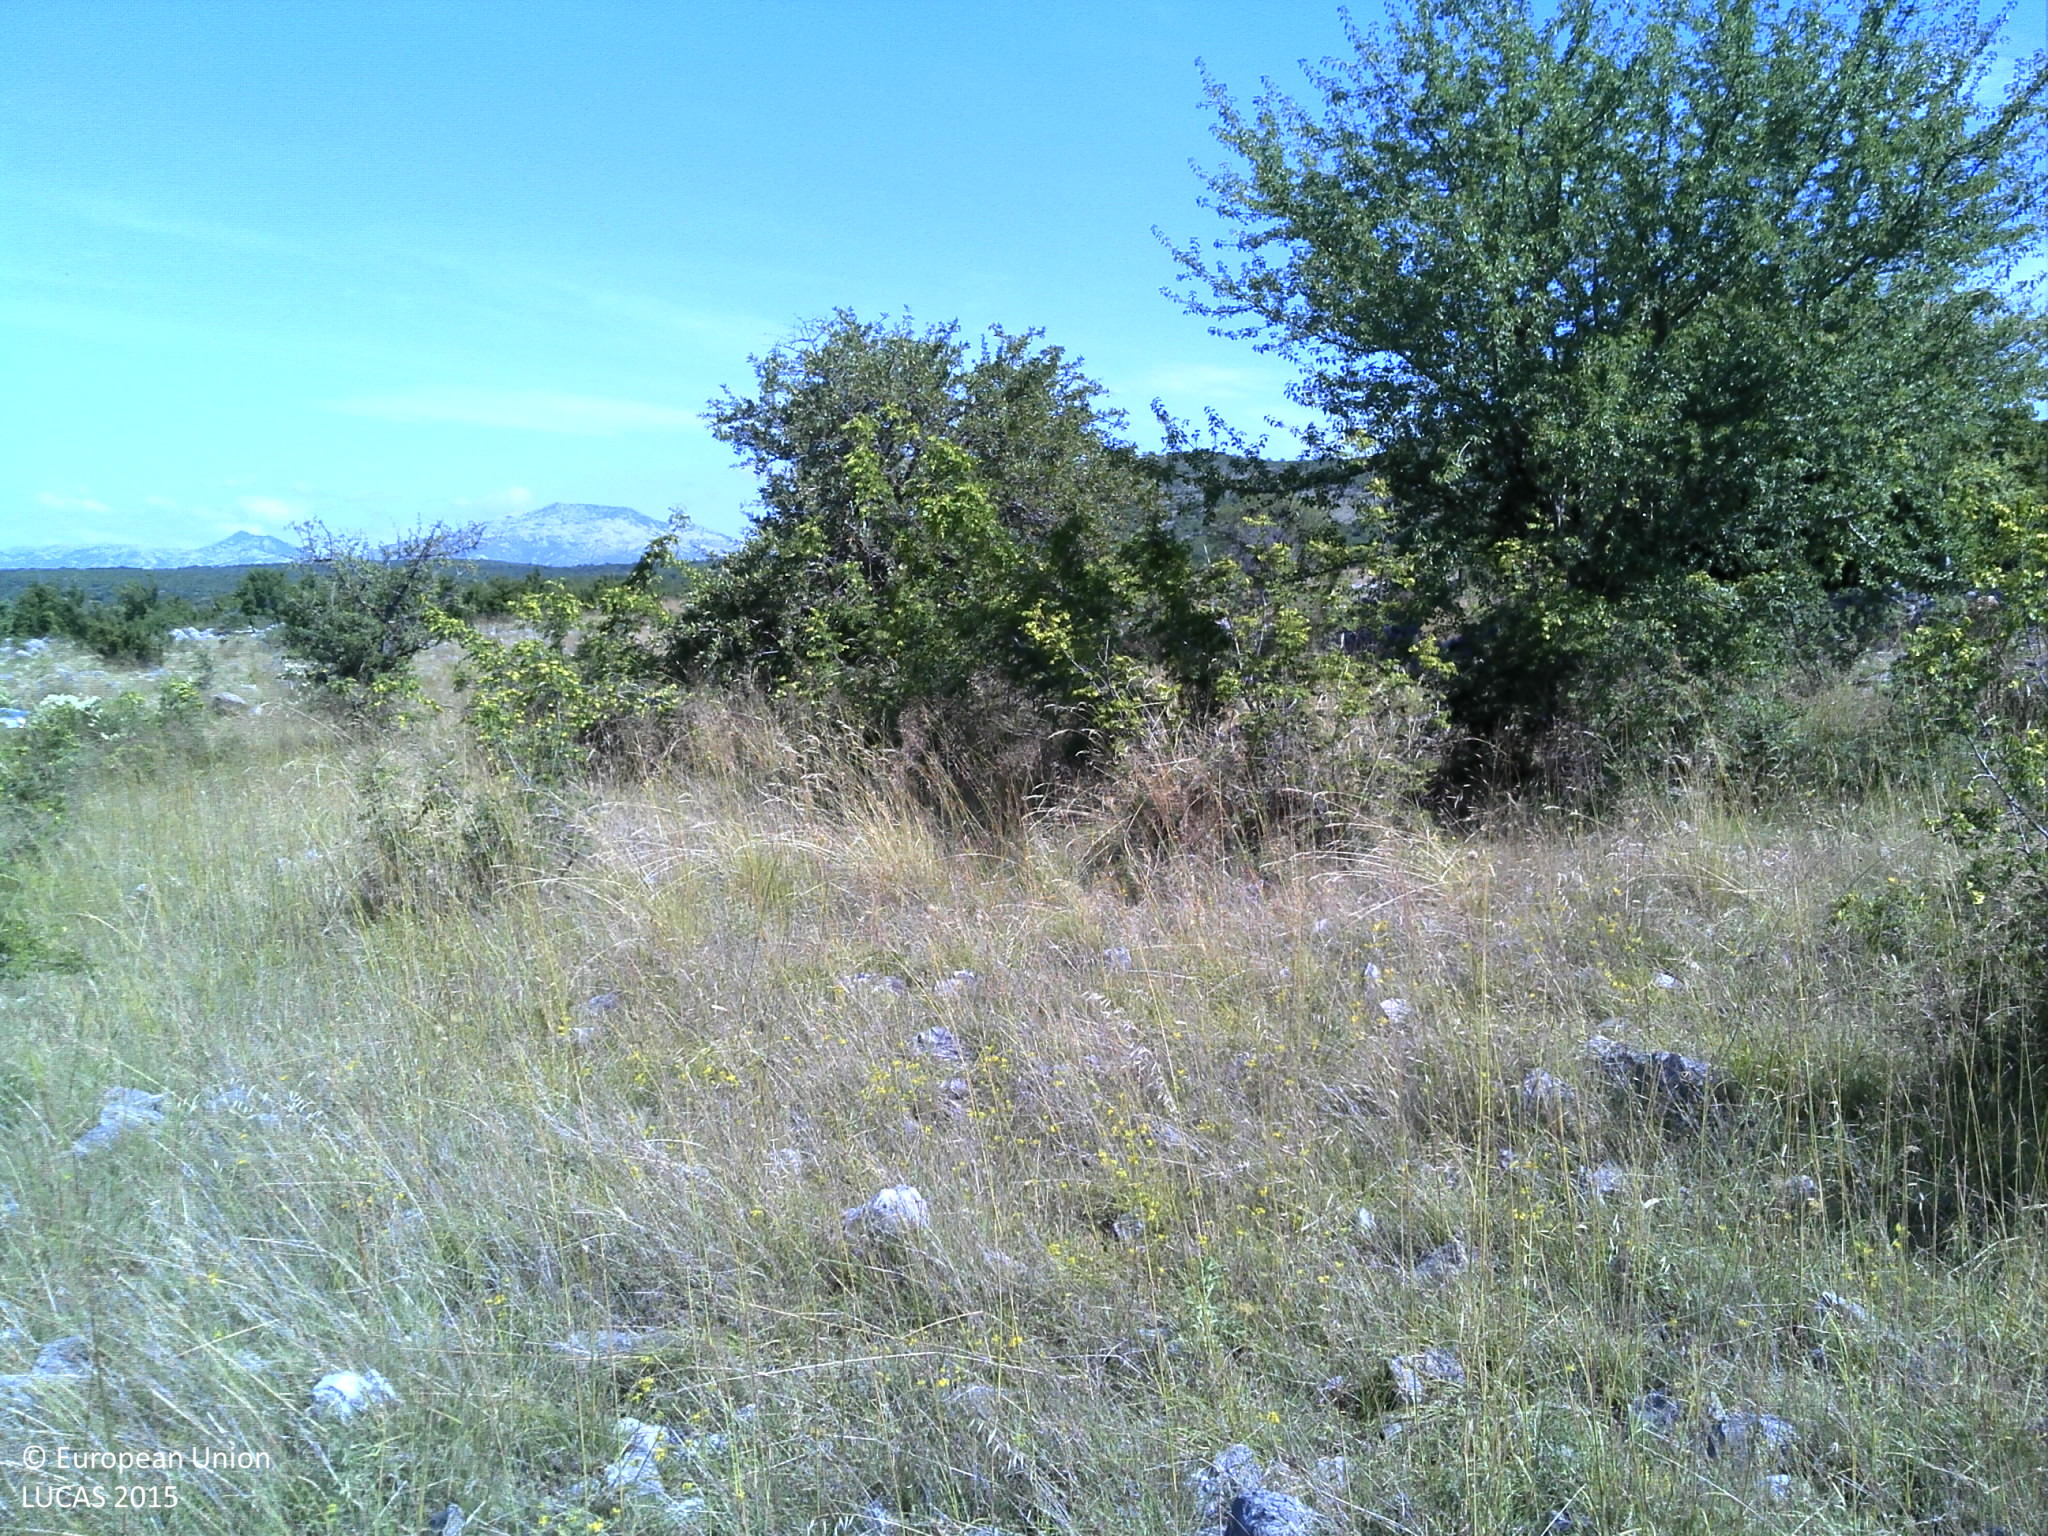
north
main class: Shrubland
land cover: Shrubland with sparse tree cover
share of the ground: 25 - 50 %
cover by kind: herbaceous plants 50 %, shrubs 40 %, broadleaved forest trees 5 %, unconsolidated bare surface 5 %
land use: Semi-natural and natural areas not in use
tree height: < 5 m
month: June
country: HR
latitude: 44.1074
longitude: 15.9518
